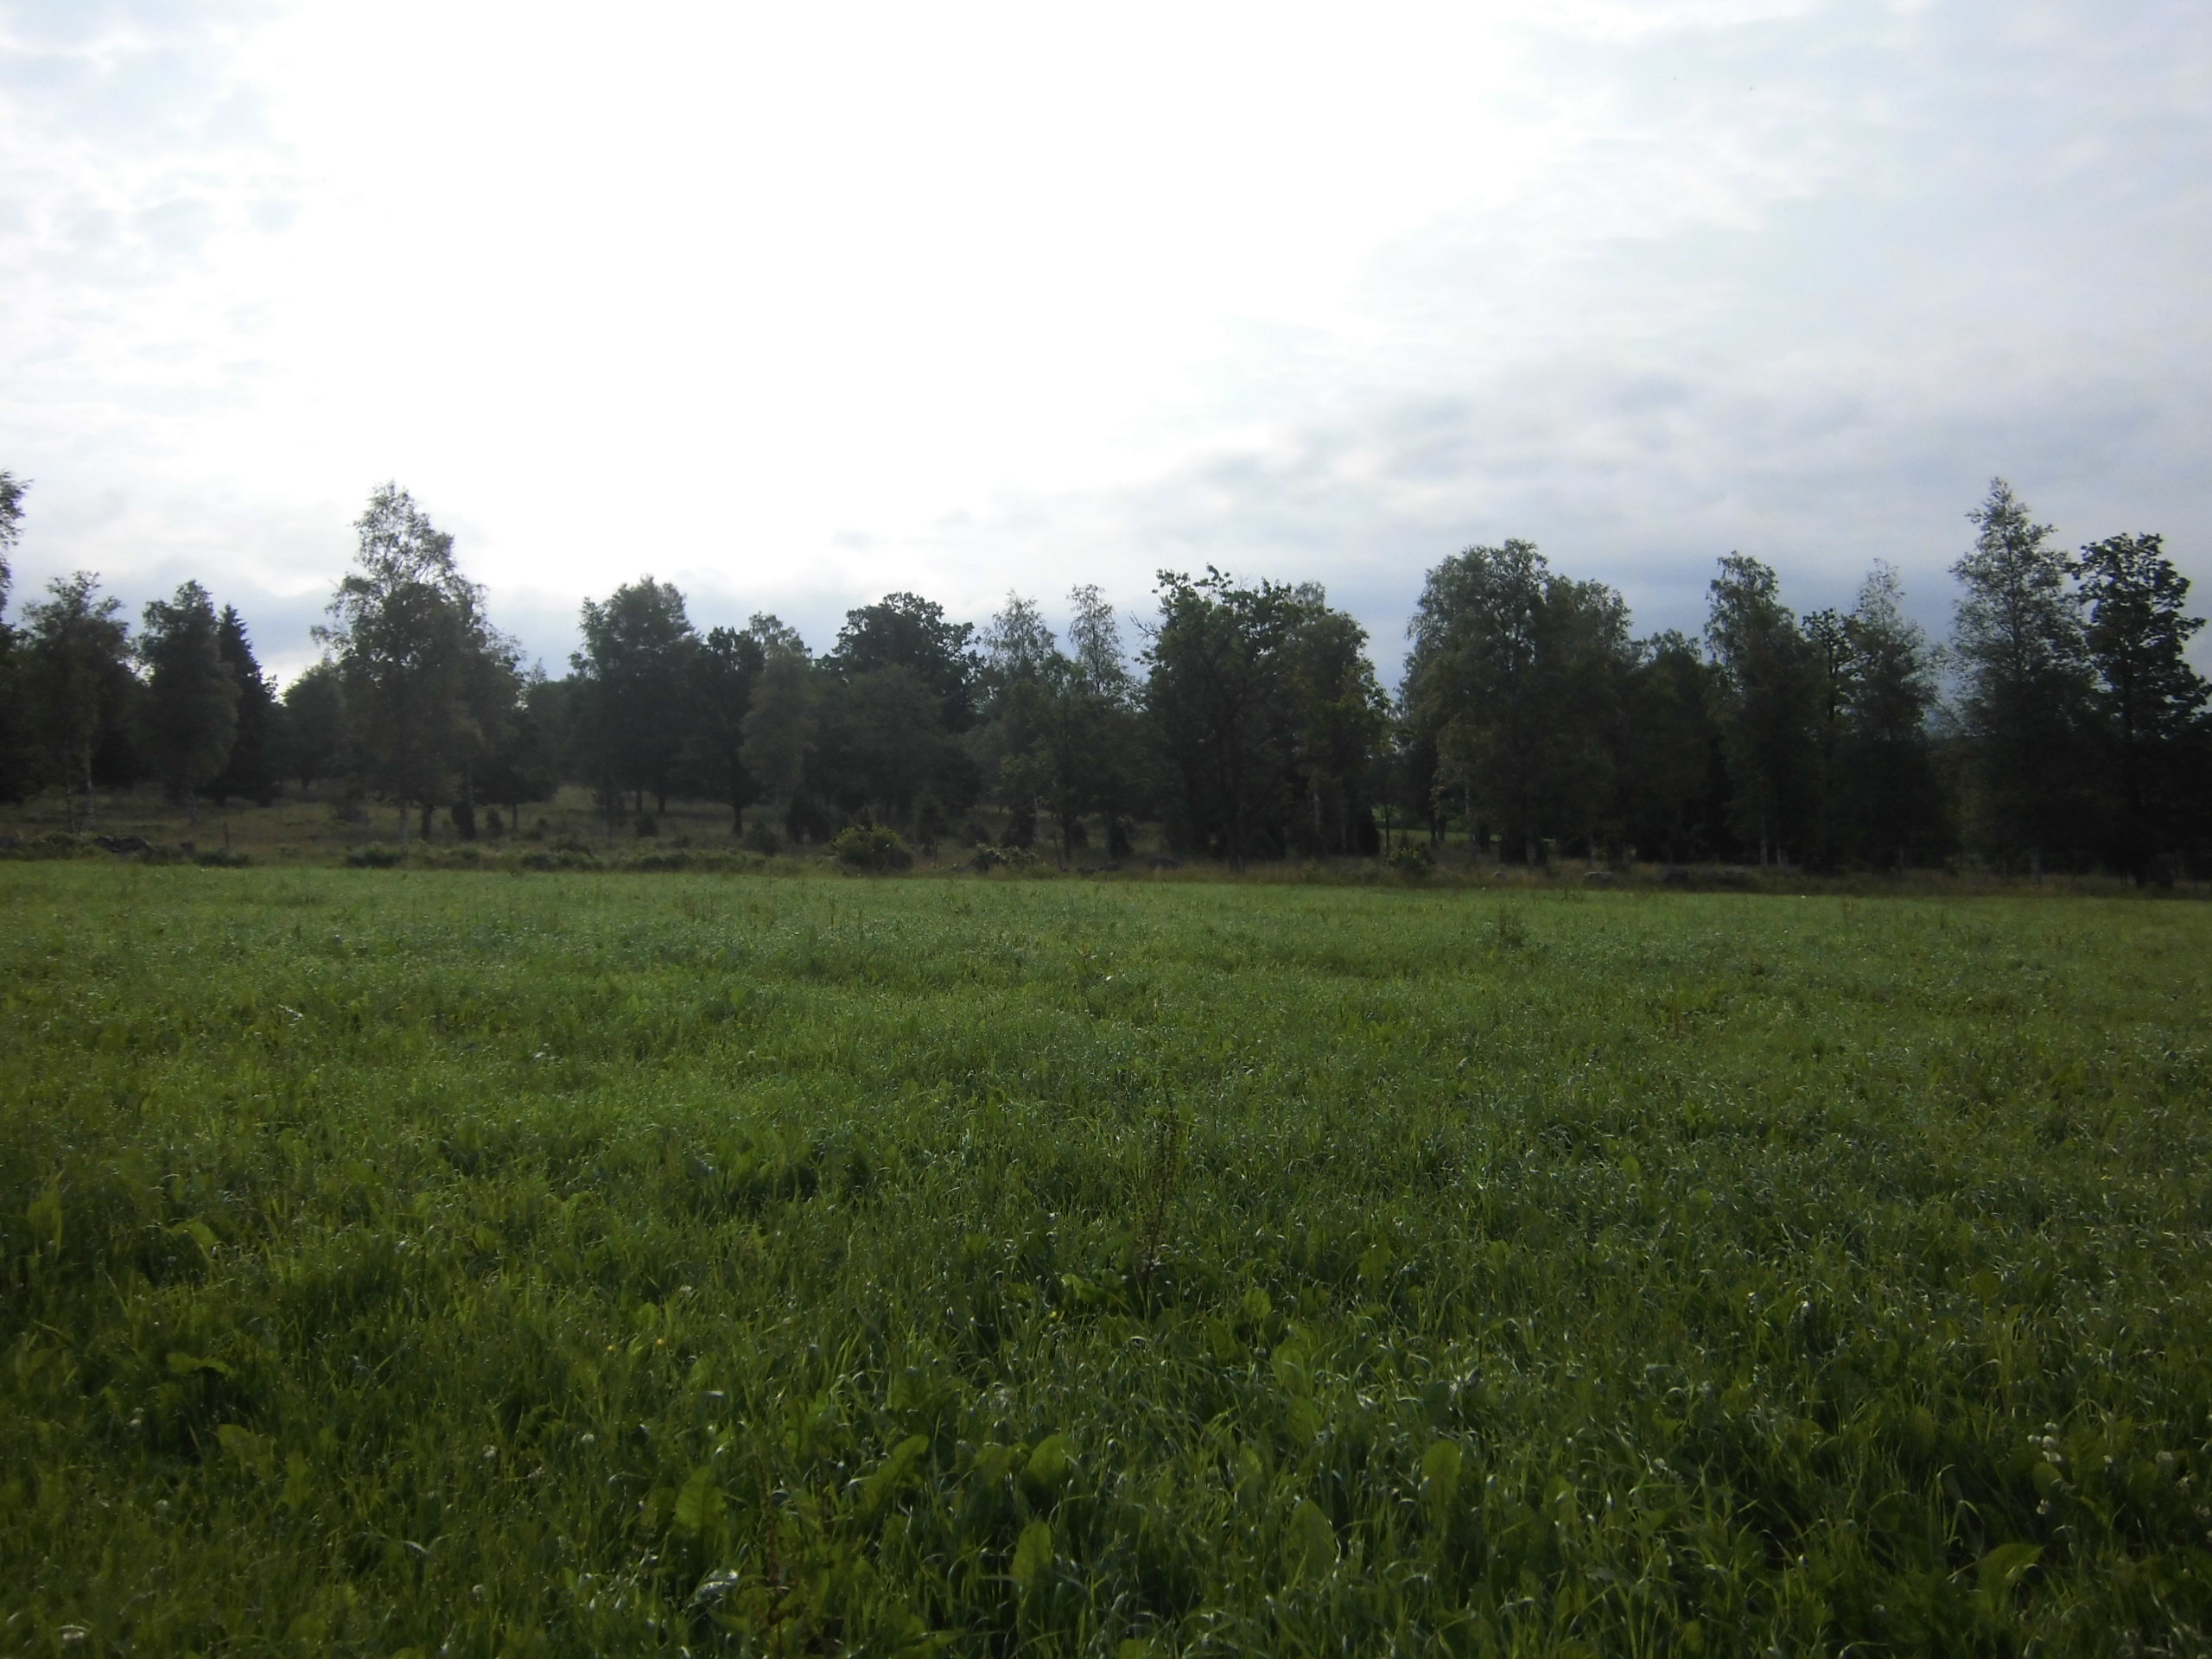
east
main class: Grassland
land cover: Grassland without tree/shrub cover
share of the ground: > 75 %
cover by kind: herbaceous plants 100 %
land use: Agriculture (excluding fallow land and kitchen gardens)
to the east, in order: Grassland without tree/shrub cover; Dry stone walls; Fences; Grassland with sparse tree/shrub cover; Broadleaved woodland; Fences; Grassland with sparse tree/shrub cover; Tracks; Ditches and canals; Fences; Groves; Grassland with sparse tree/shrub cover; Broadleaved woodland; Dry stone walls; Fences; Groves; Grassland without tree/shrub cover
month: July
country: SE
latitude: 57.4308
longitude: 14.8095
